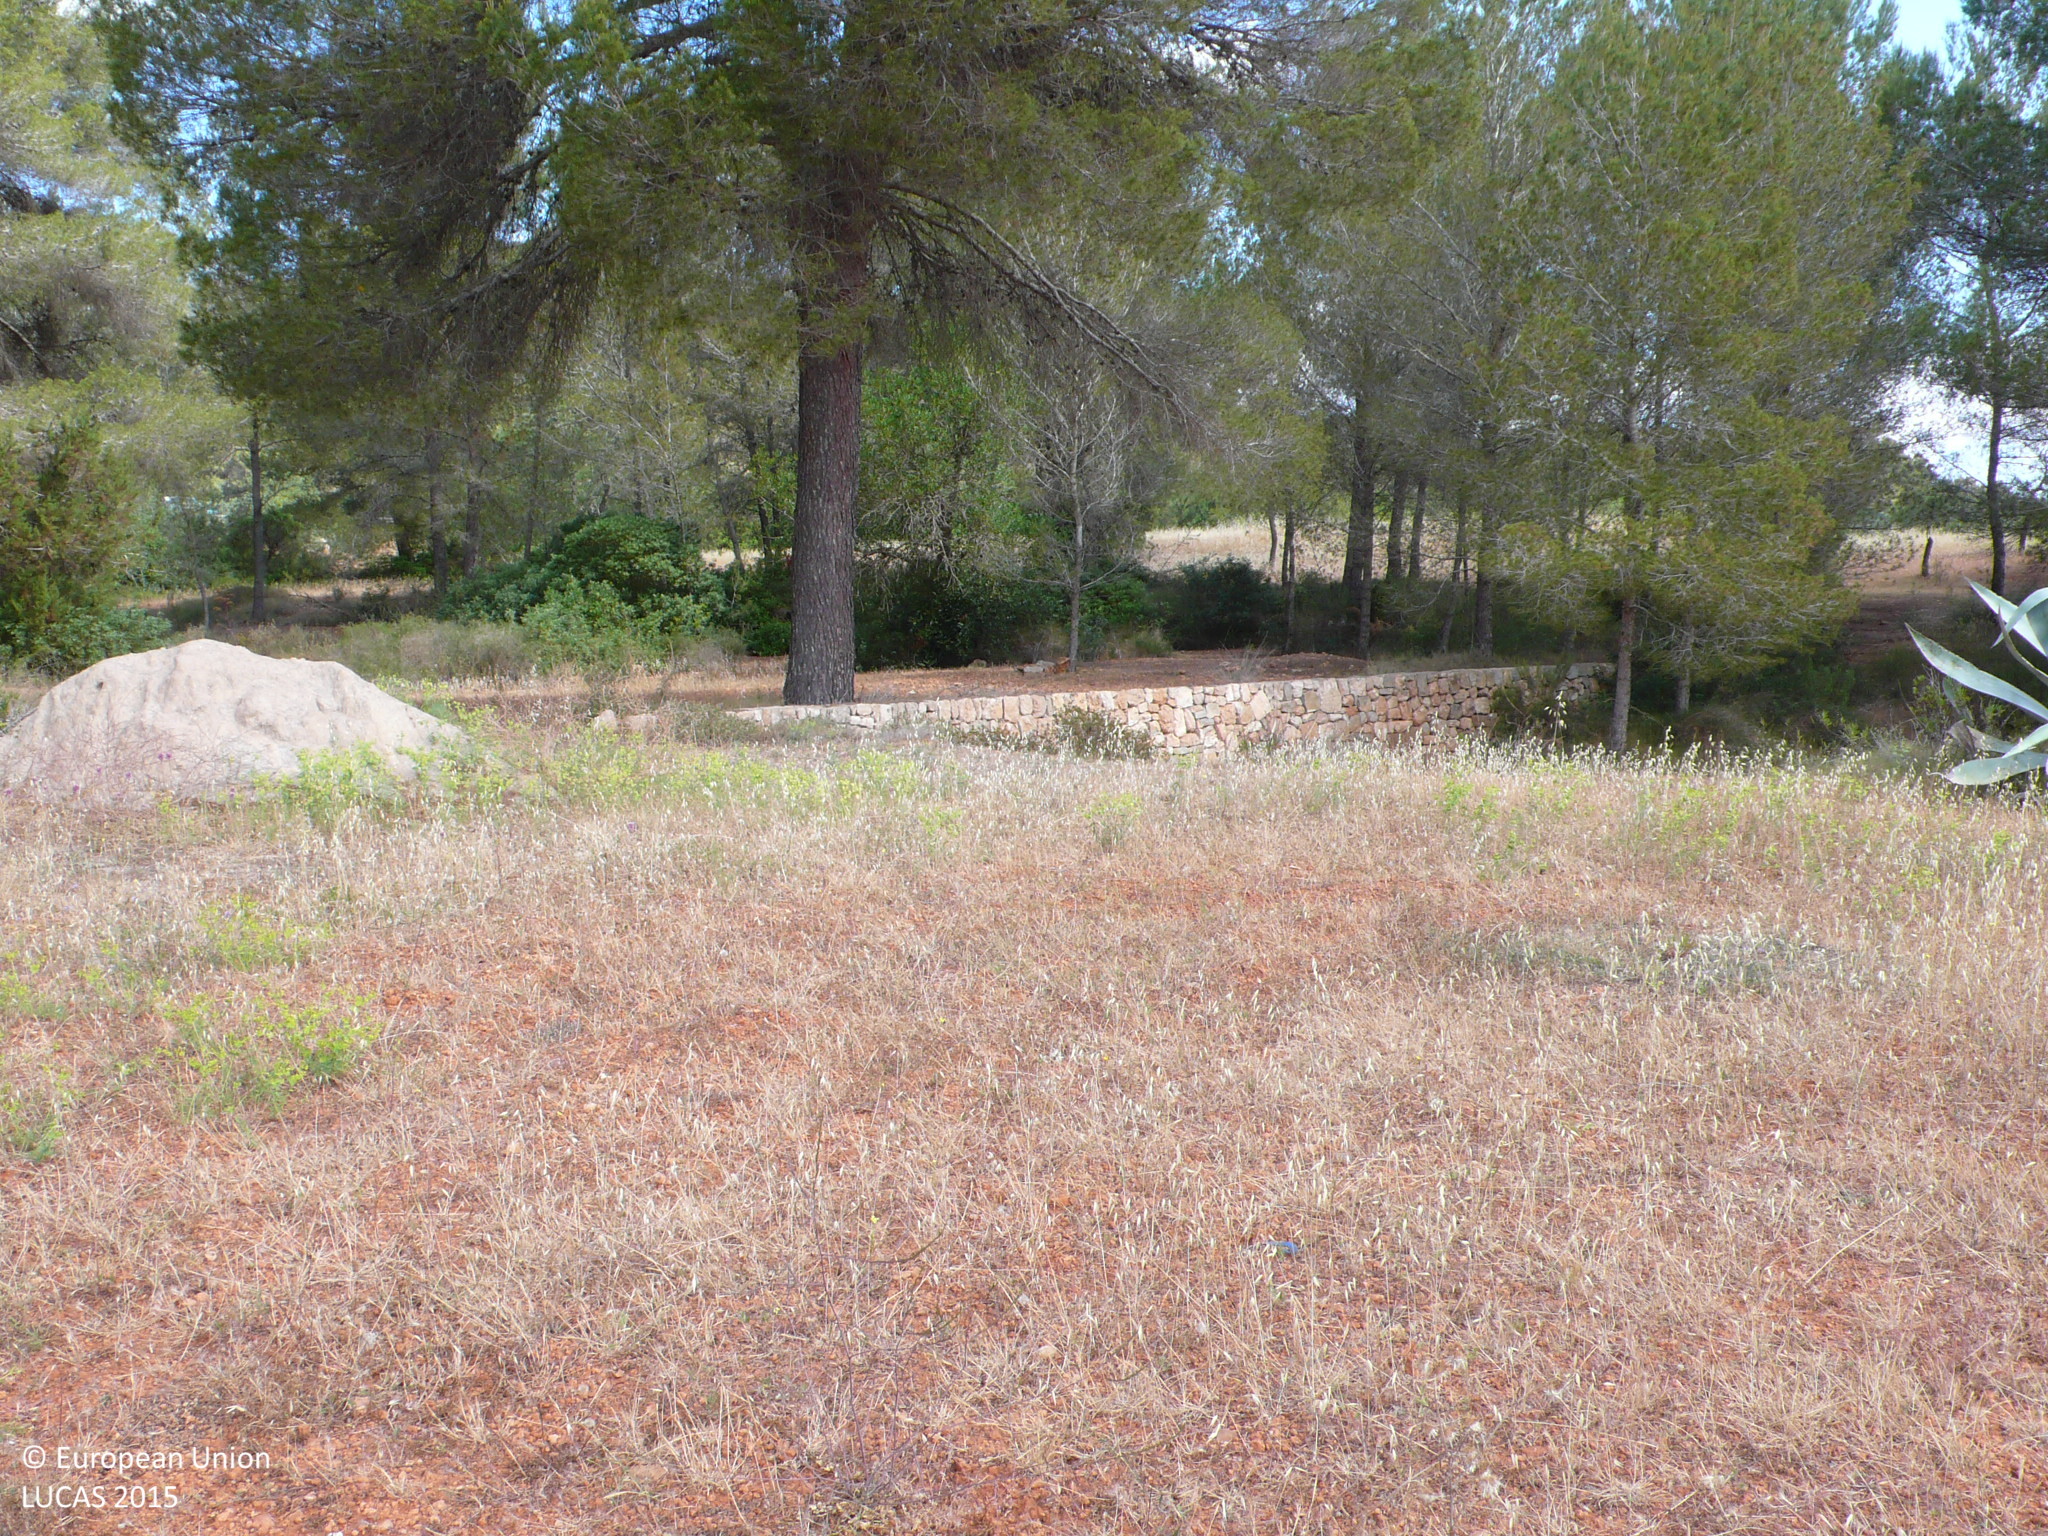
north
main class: Grassland
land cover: Spontaneously vegetated surfaces
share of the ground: 25 - 50 %
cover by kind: consolidated bare surface 60 %, herbaceous plants 40 %
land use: Construction
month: May
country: ES
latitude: 38.9863
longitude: 1.4807
